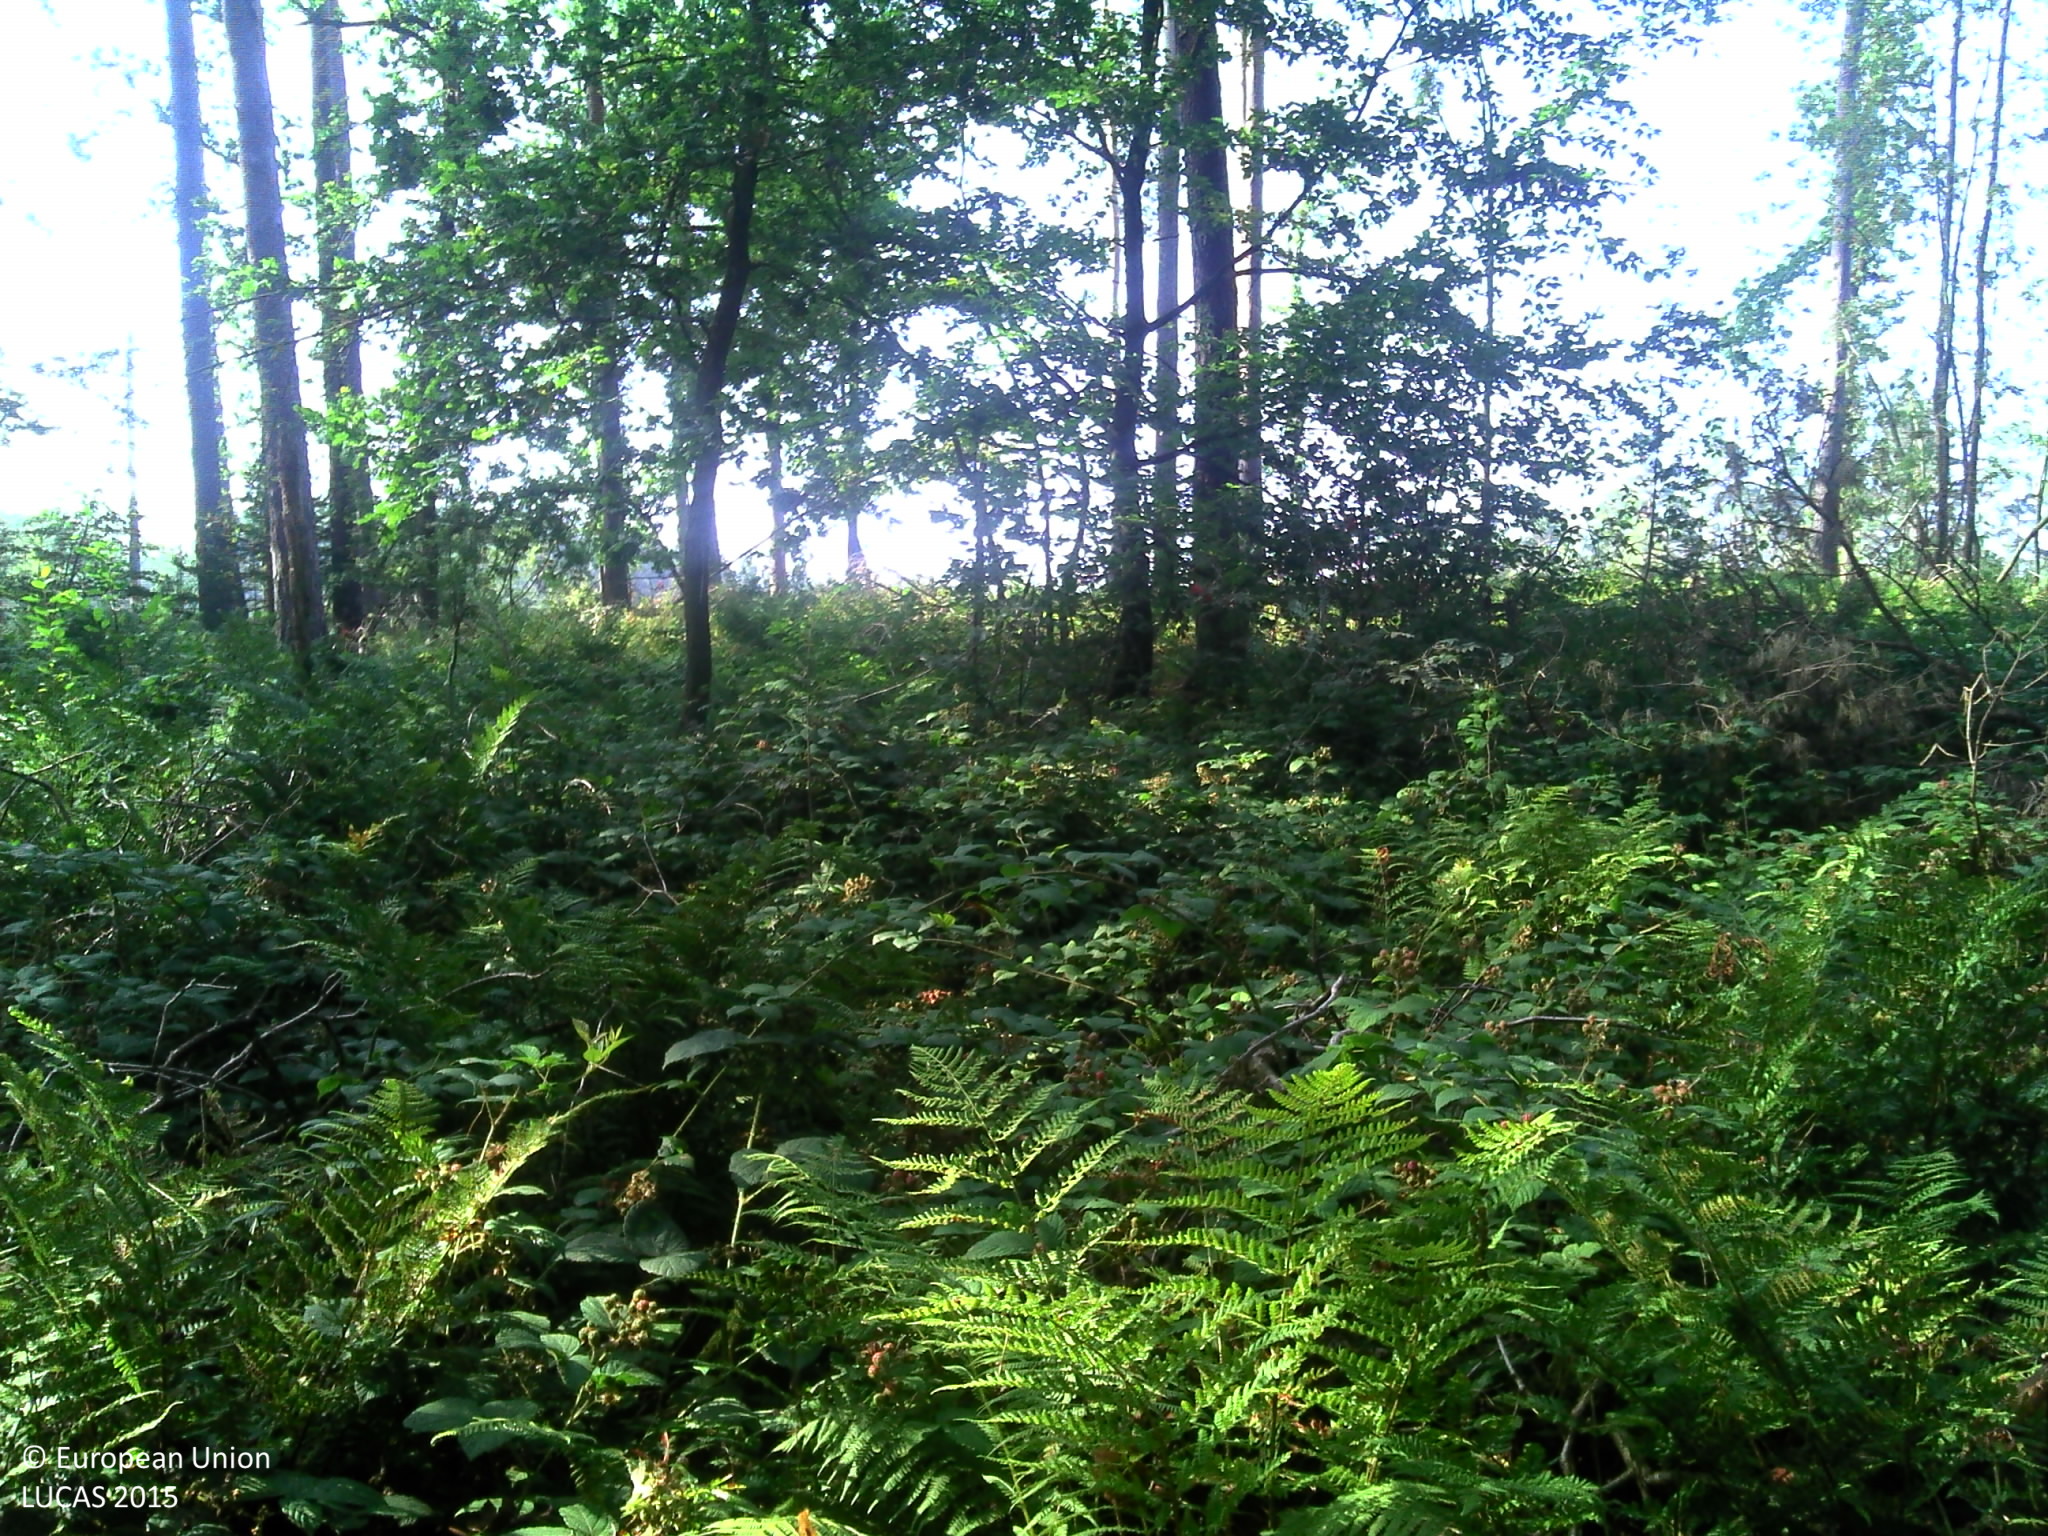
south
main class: Woodland
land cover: Pine dominated mixed woodland
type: hemiboreal forest and nemoral coniferous forest and mixed broadleaved-coniferous forest
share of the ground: > 75 %
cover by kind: coniferous forest trees 50 %, broadleaved forest trees 30 %, herbaceous plants 20 %
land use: Forestry
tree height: > 5 m
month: August
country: BE
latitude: 50.3314
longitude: 5.5450
